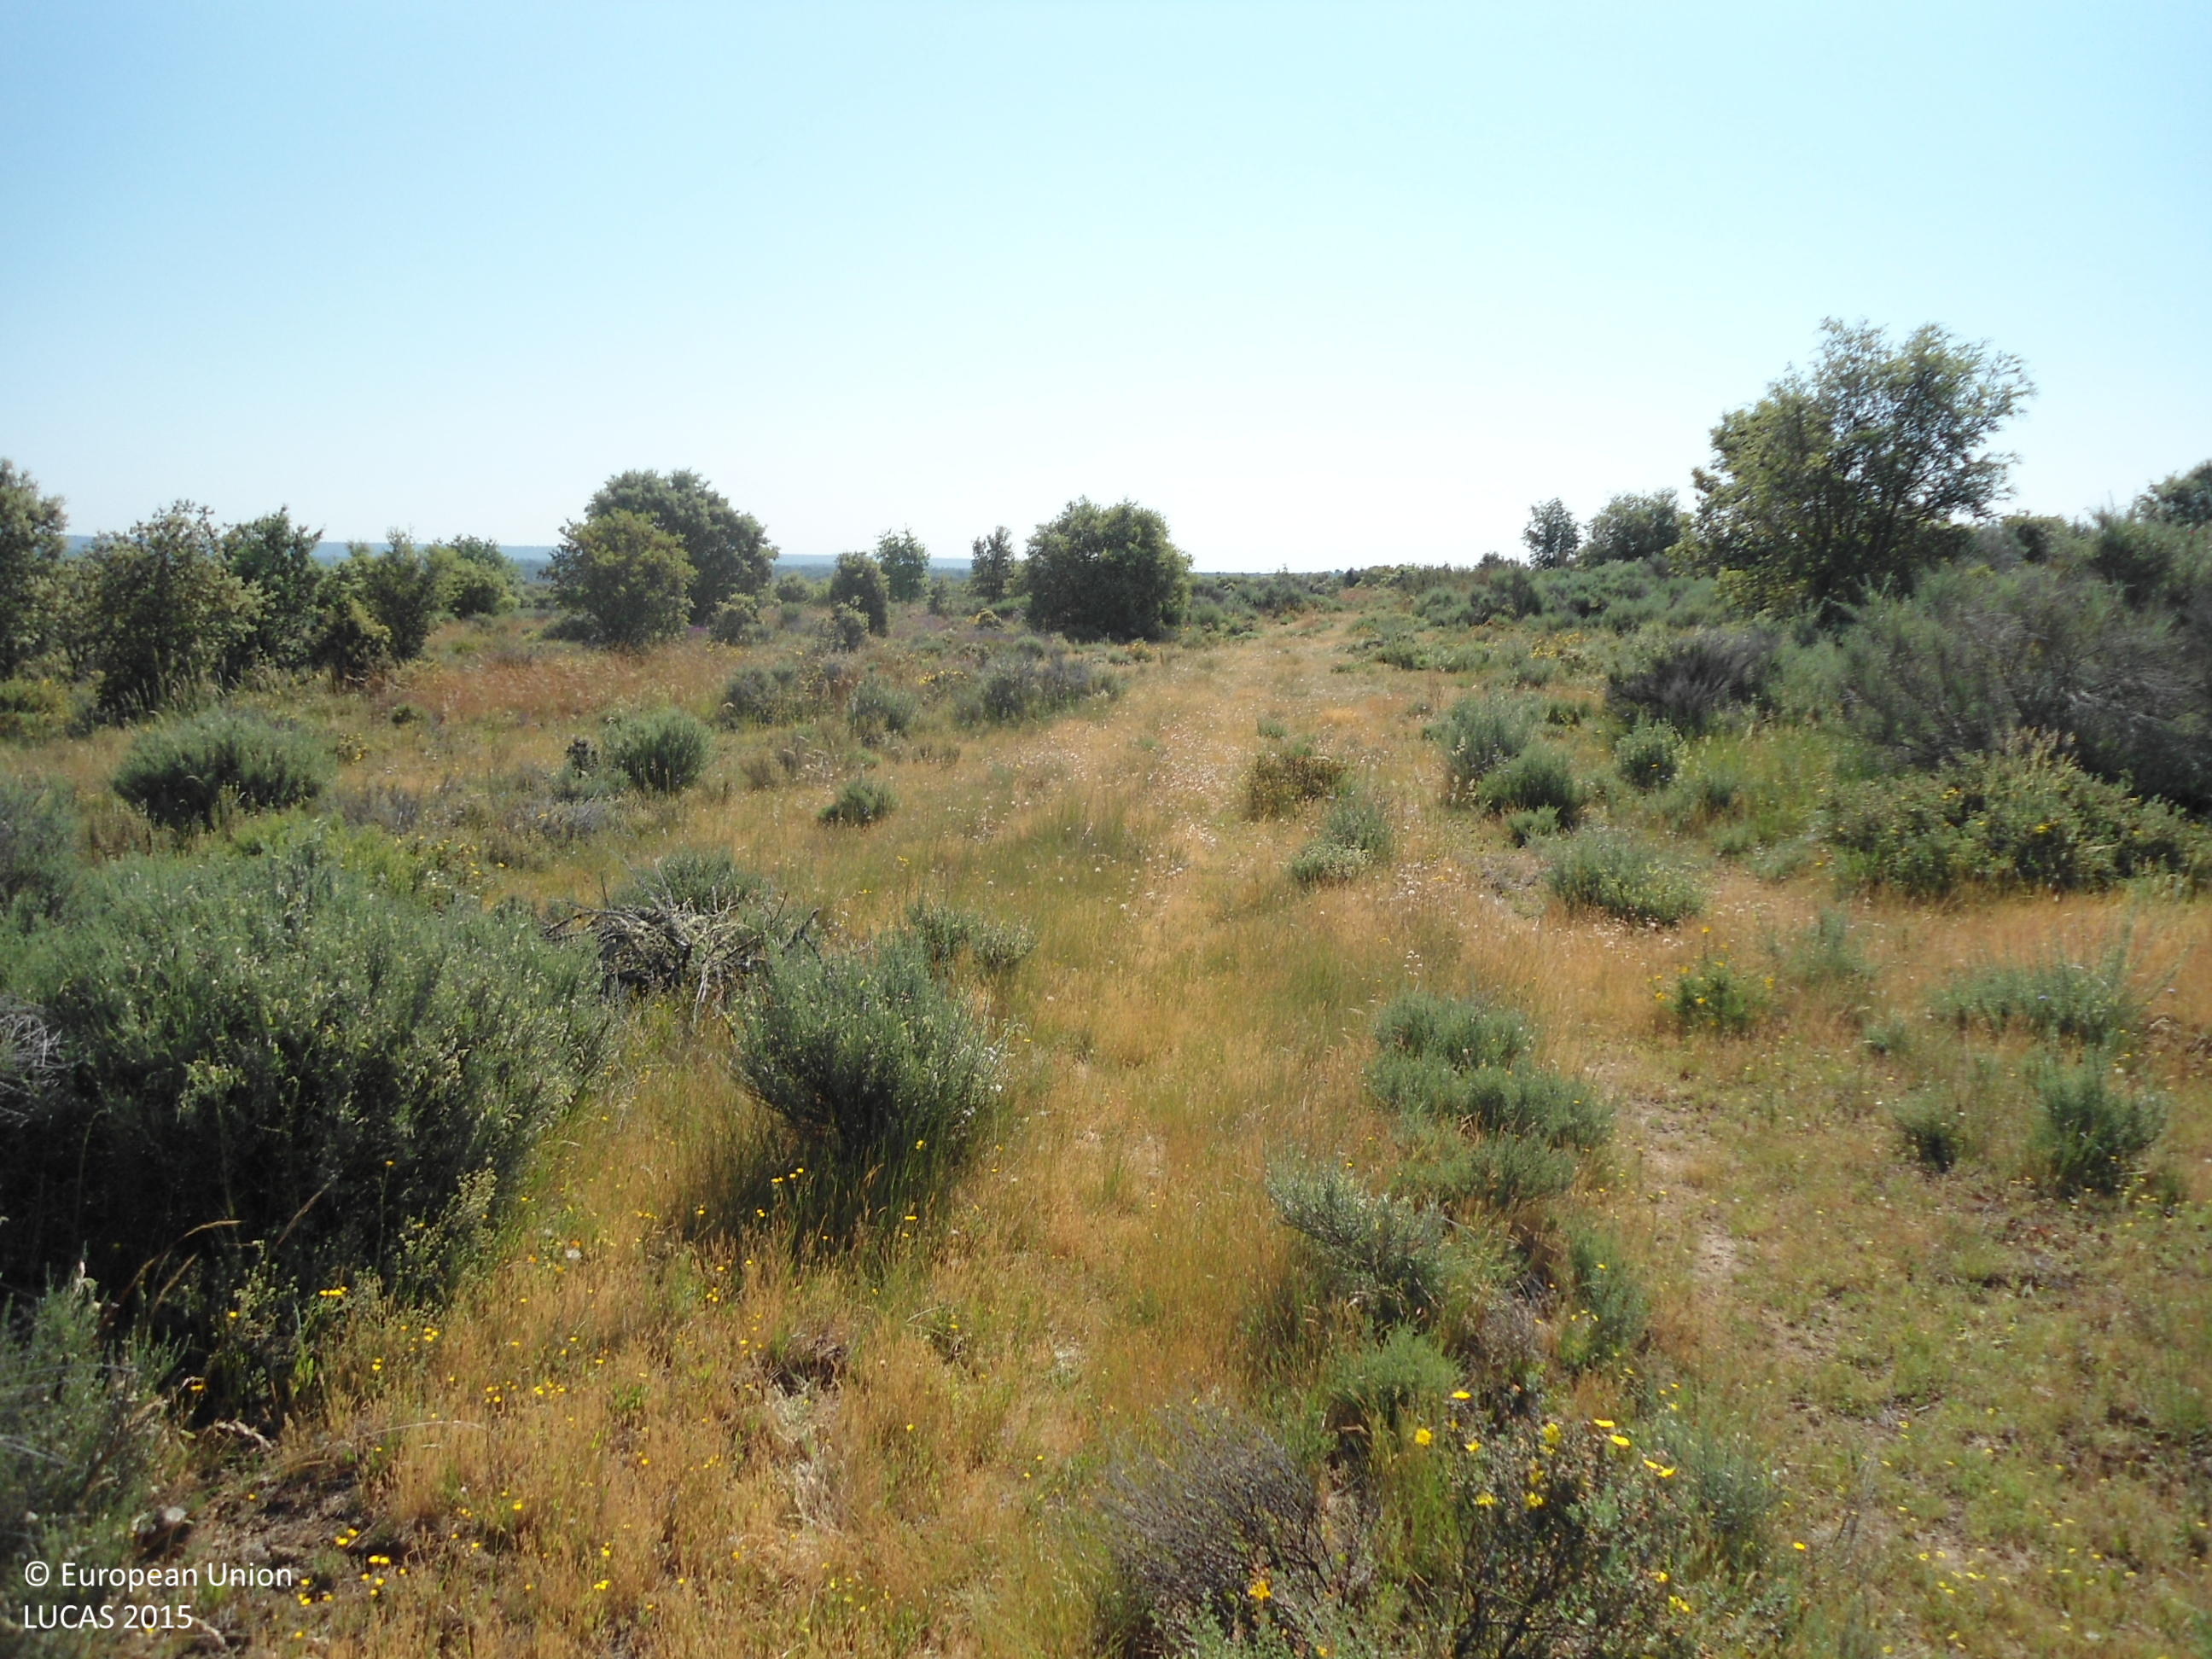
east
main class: Shrubland
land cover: Shrubland without tree cover
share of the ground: > 75 %
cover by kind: shrubs 80 %, herbaceous plants 20 %
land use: Semi-natural and natural areas not in use
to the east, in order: Tracks; Shrubland without tree cover; Shrubland with sparse tree cover; Spontaneously vegetated surfaces; Broadleaved woodland; Spontaneously vegetated surfaces; Shrubland with sparse tree cover; Spontaneously vegetated surfaces; Shrubland with sparse tree cover; Spontaneously vegetated surfaces; Shrubland with sparse tree cover
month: June
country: ES
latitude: 42.0686
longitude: -6.2393
